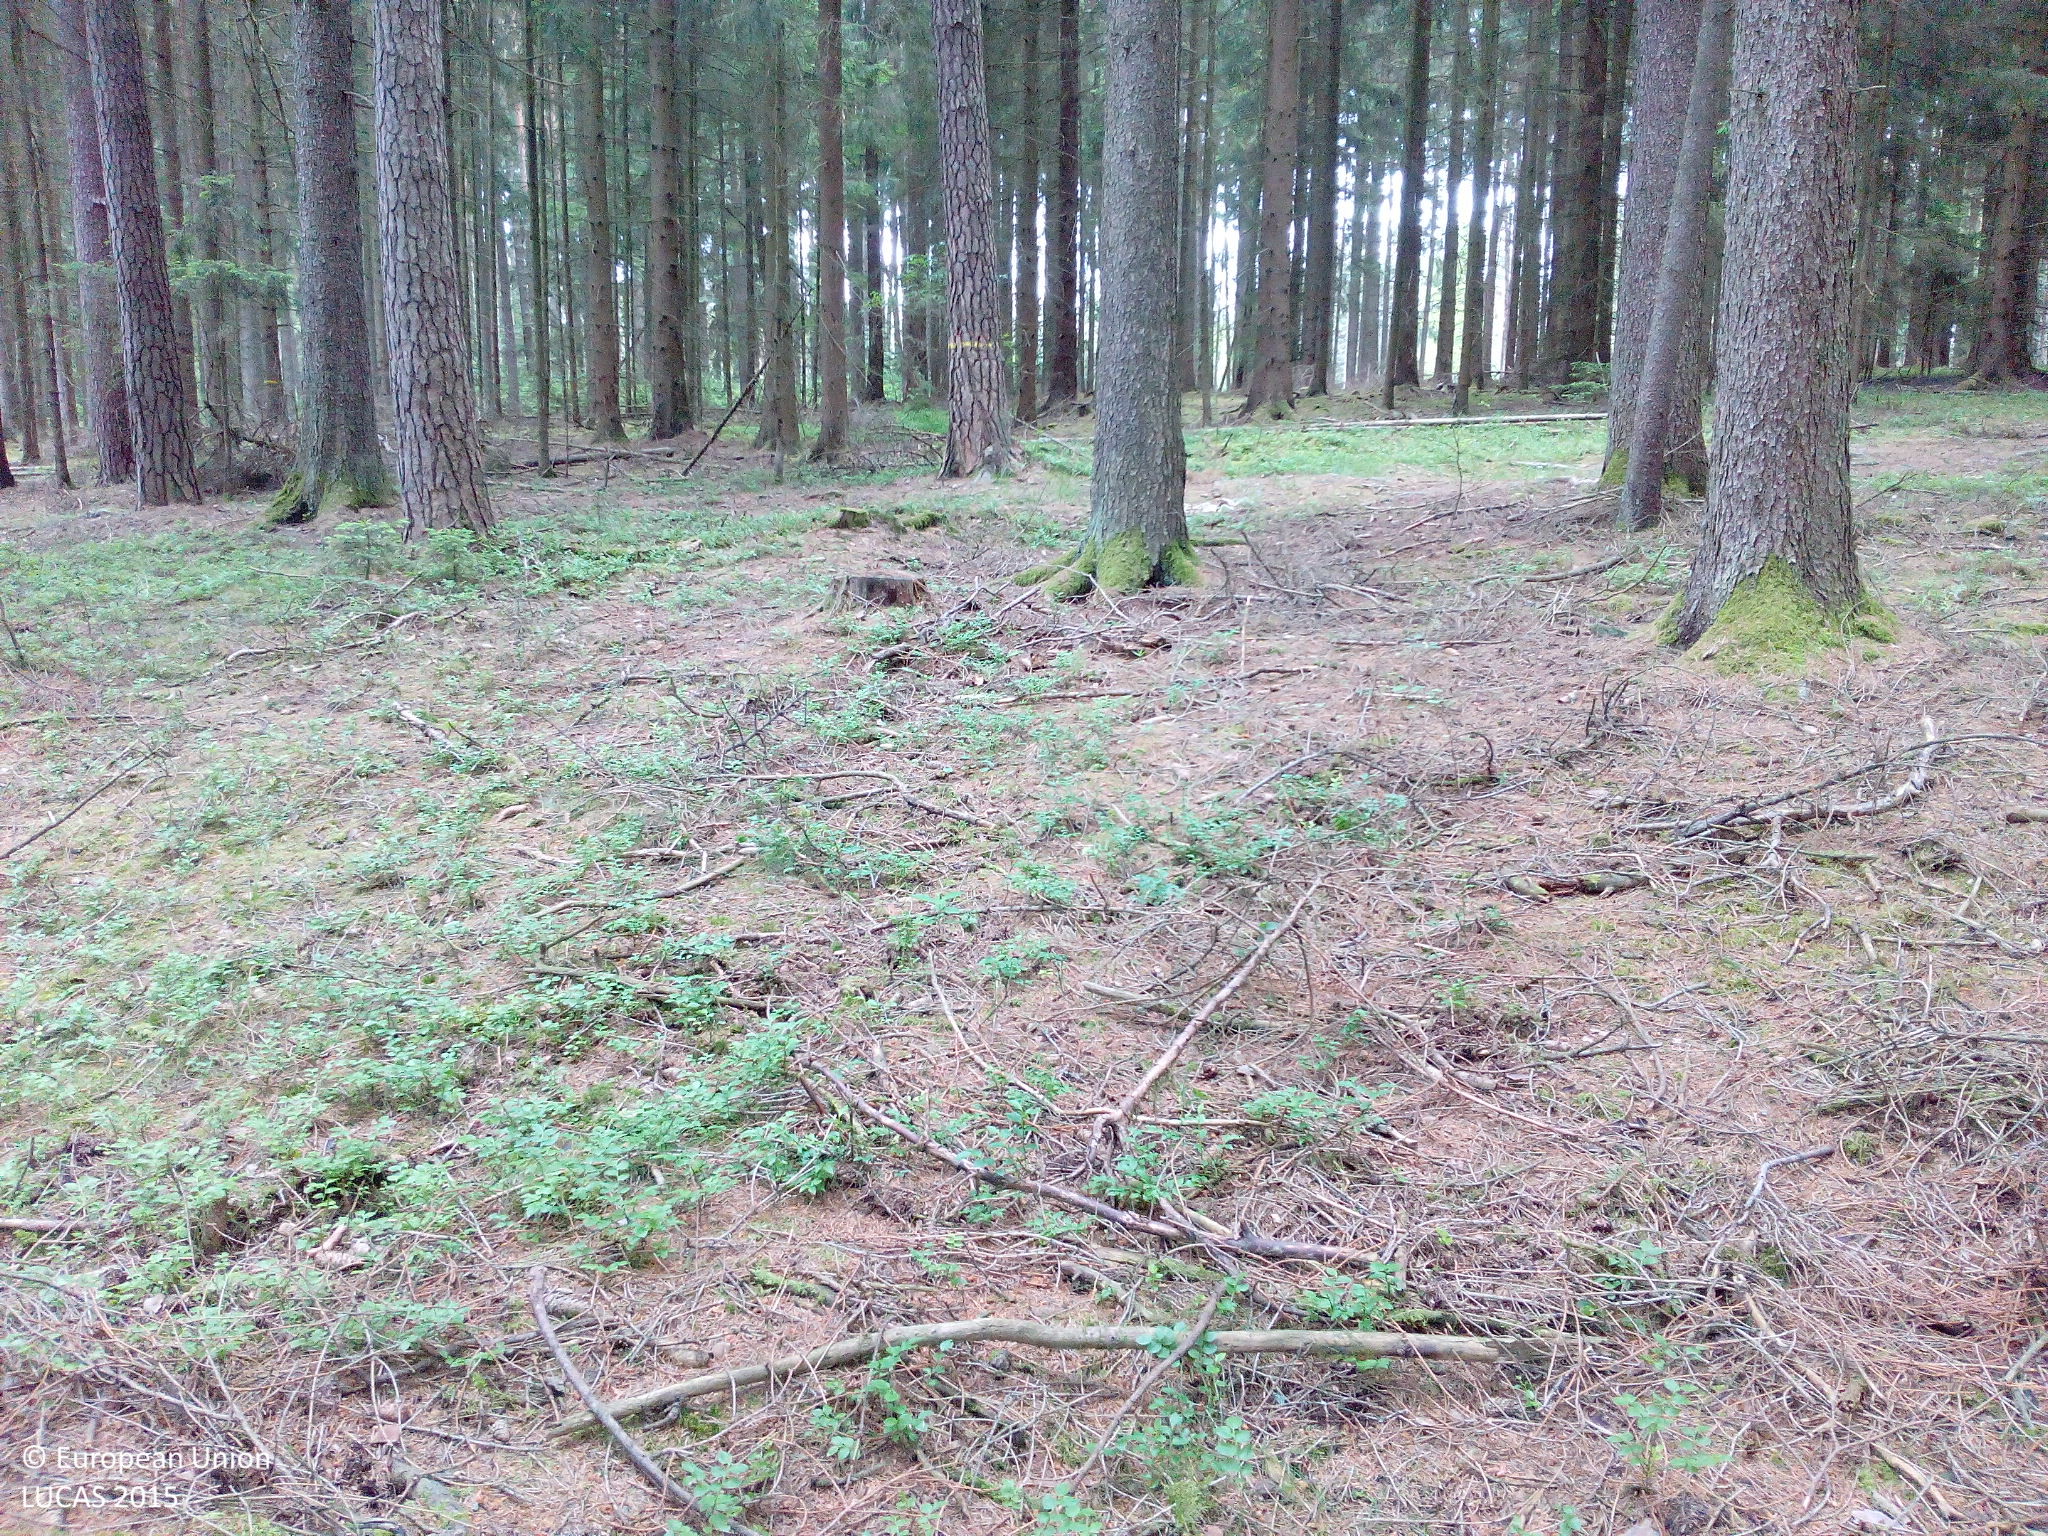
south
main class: Woodland
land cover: Spruce dominated coniferous woodland
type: hemiboreal forest and nemoral coniferous forest and mixed broadleaved-coniferous forest
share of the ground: 50 - 75 %
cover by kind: coniferous forest trees 70 %, herbaceous plants 10 %, lichens and mosses 10 %, unconsolidated bare surface 10 %
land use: Forestry
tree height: > 5 m
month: June
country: DE
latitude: 48.9267
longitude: 11.9238
